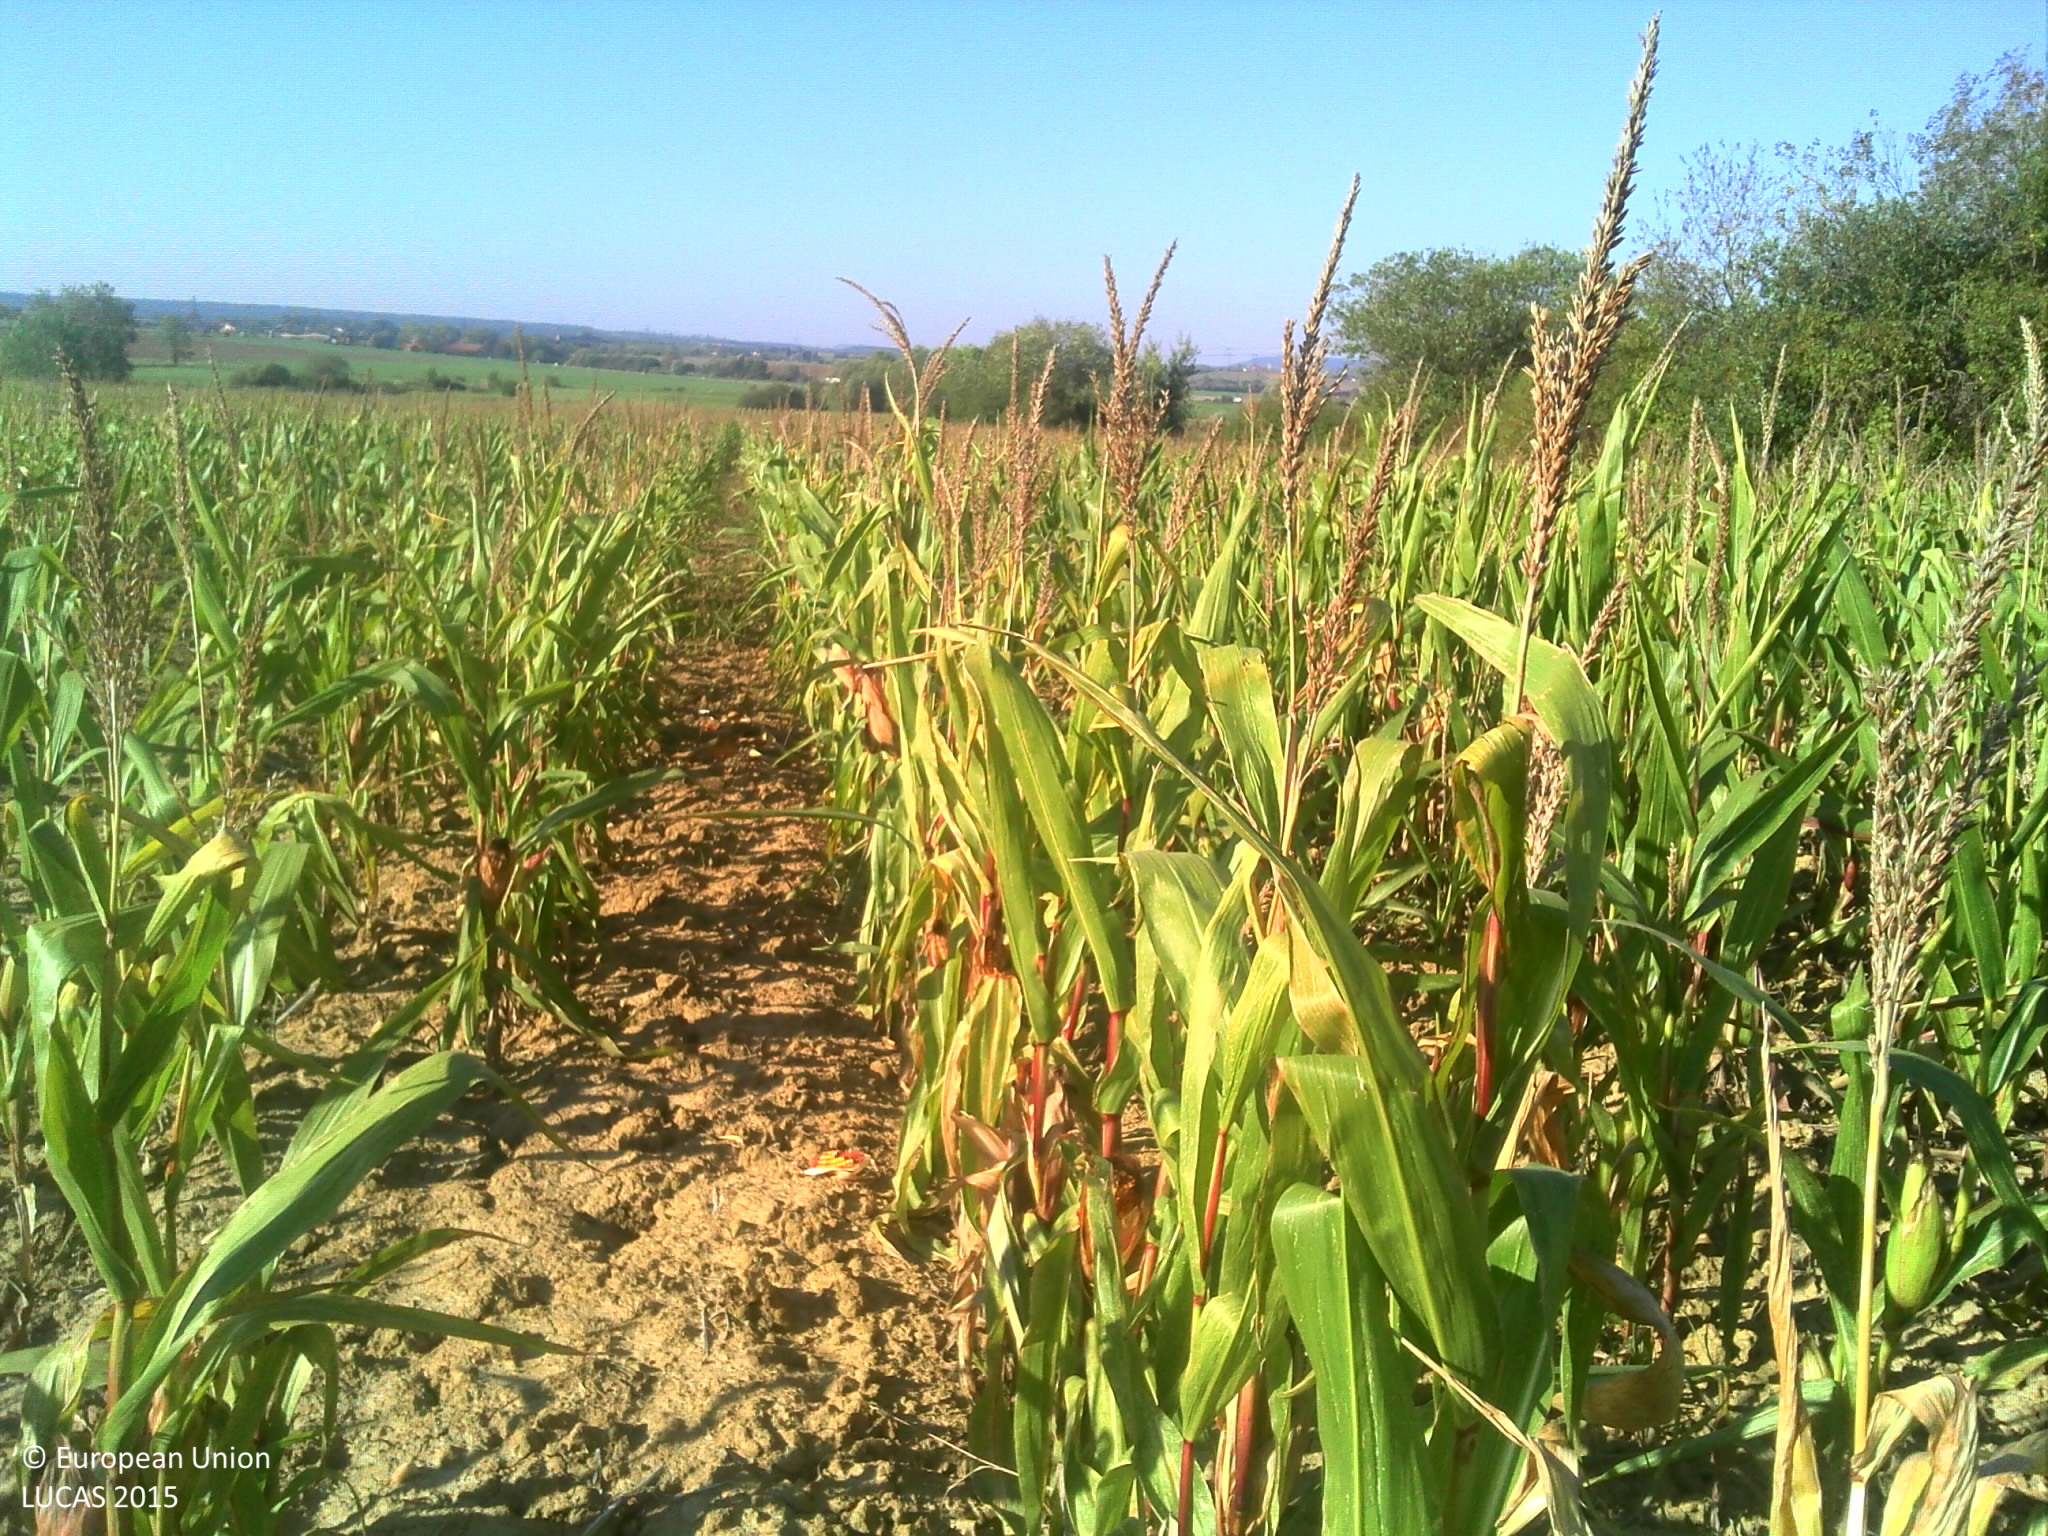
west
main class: Cropland
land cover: Maize
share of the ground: > 75 %
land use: Agriculture (excluding fallow land and kitchen gardens)
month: October
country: FR
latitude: 48.6287
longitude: 6.2689
